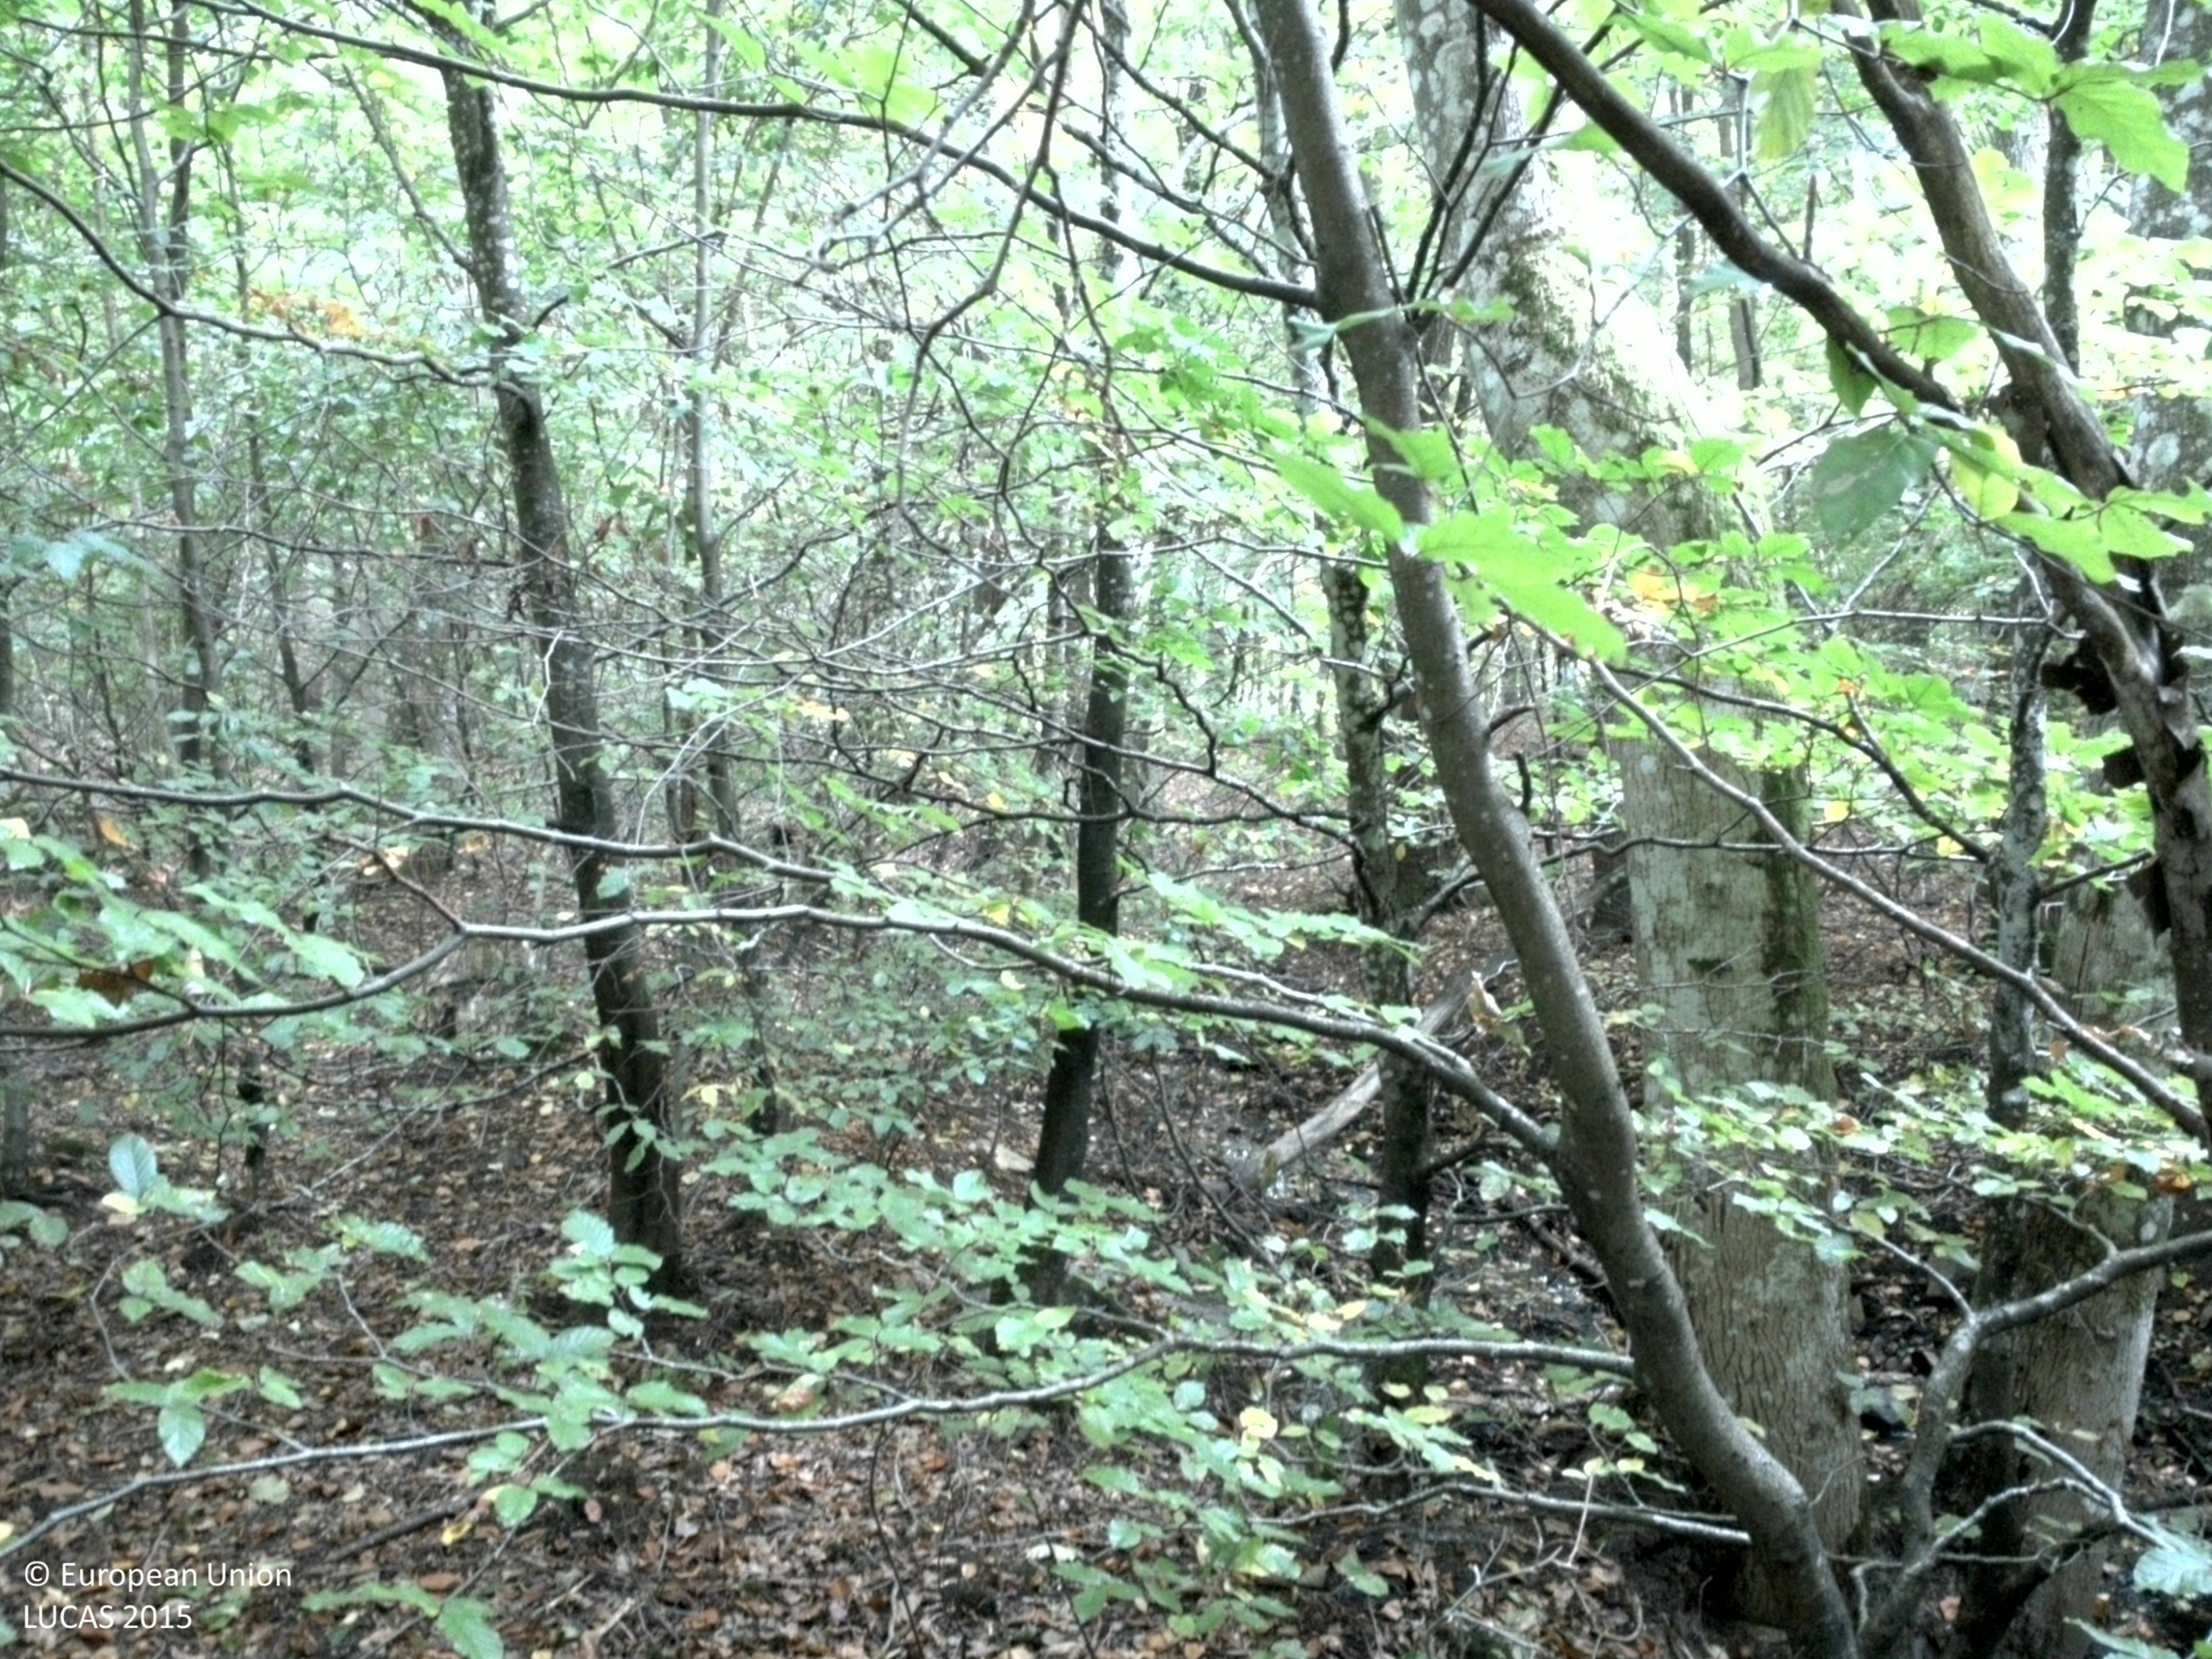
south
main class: Woodland
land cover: Broadleaved woodland
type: beech forest
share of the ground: > 75 %
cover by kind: broadleaved forest trees 80 %, unconsolidated bare surface 10 %, shrubs 5 %, herbaceous plants 5 %
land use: Forestry
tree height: > 5 m
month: October
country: SE
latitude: 55.6379
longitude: 14.0494
